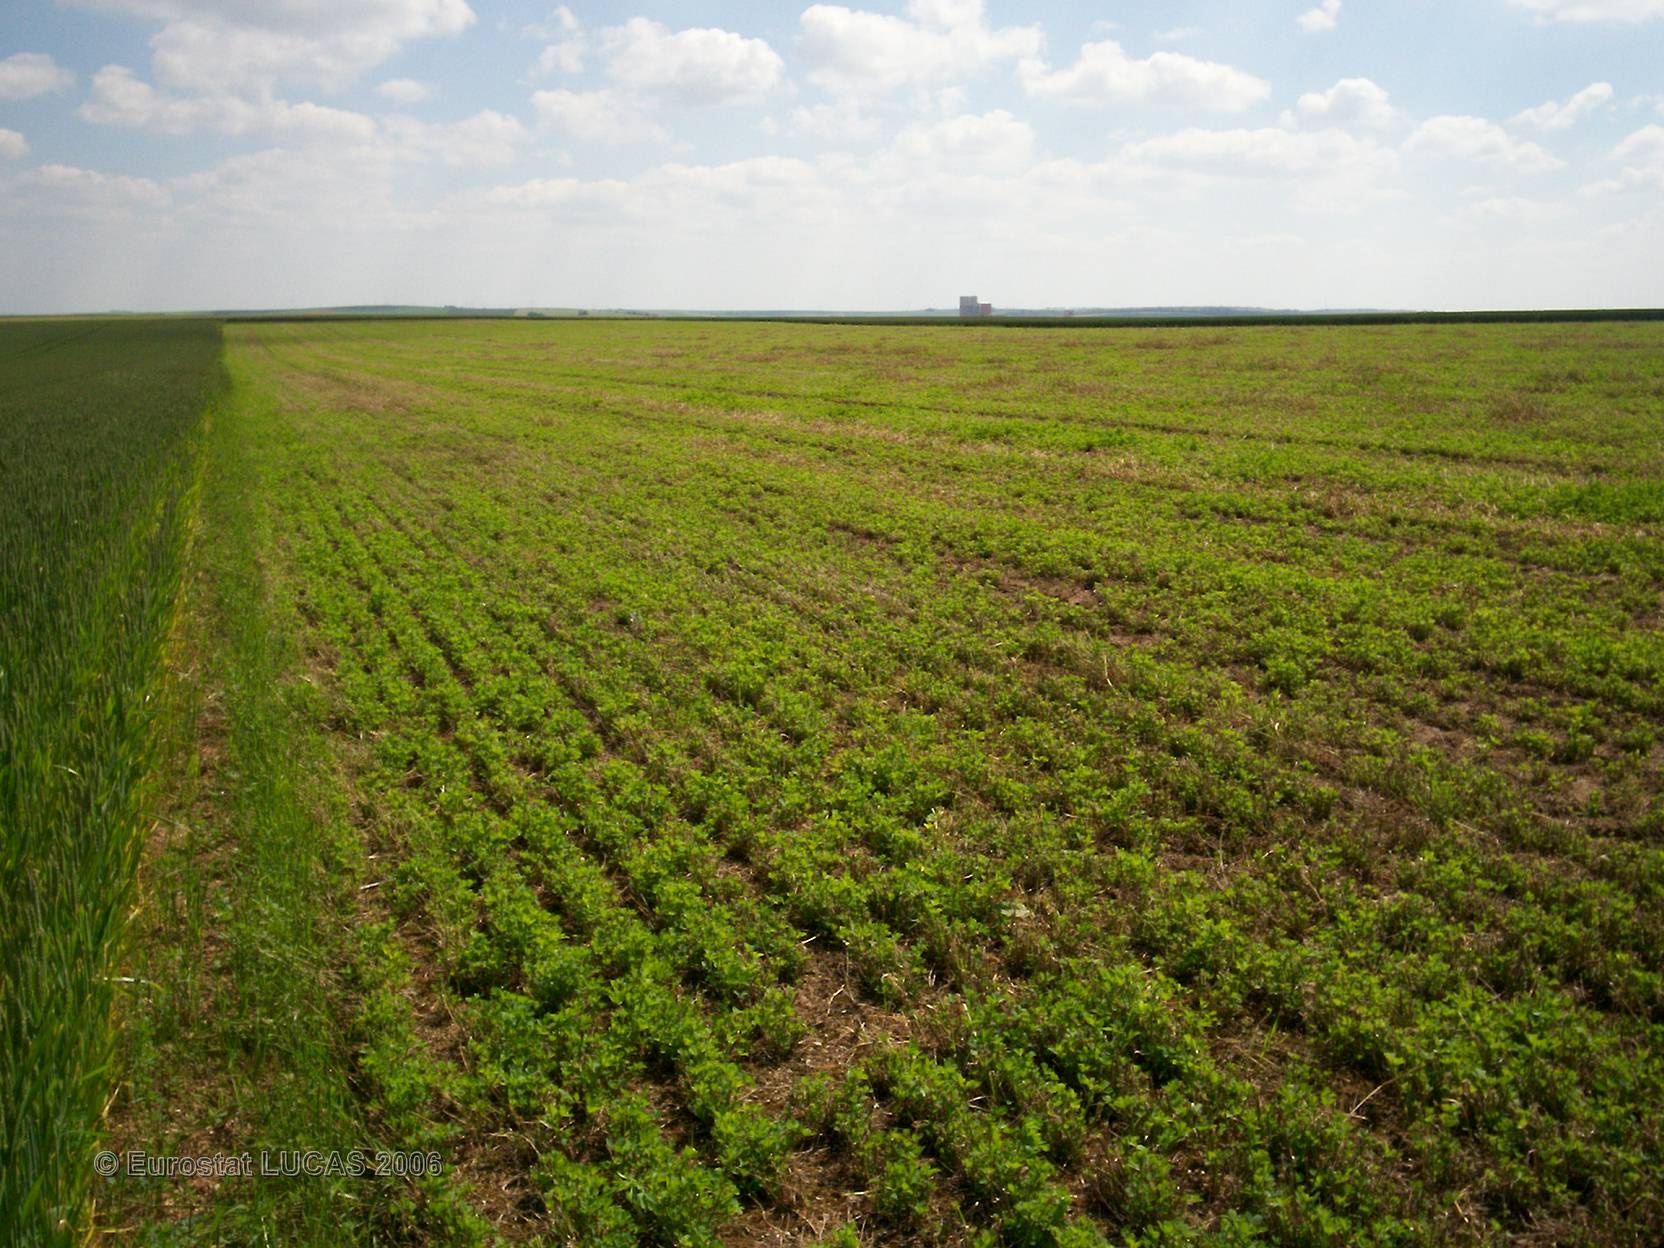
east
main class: Cropland
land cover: Common wheat
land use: Agriculture (excluding fallow land and kitchen gardens)
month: June
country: FR
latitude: 48.7888
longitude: 4.4843
